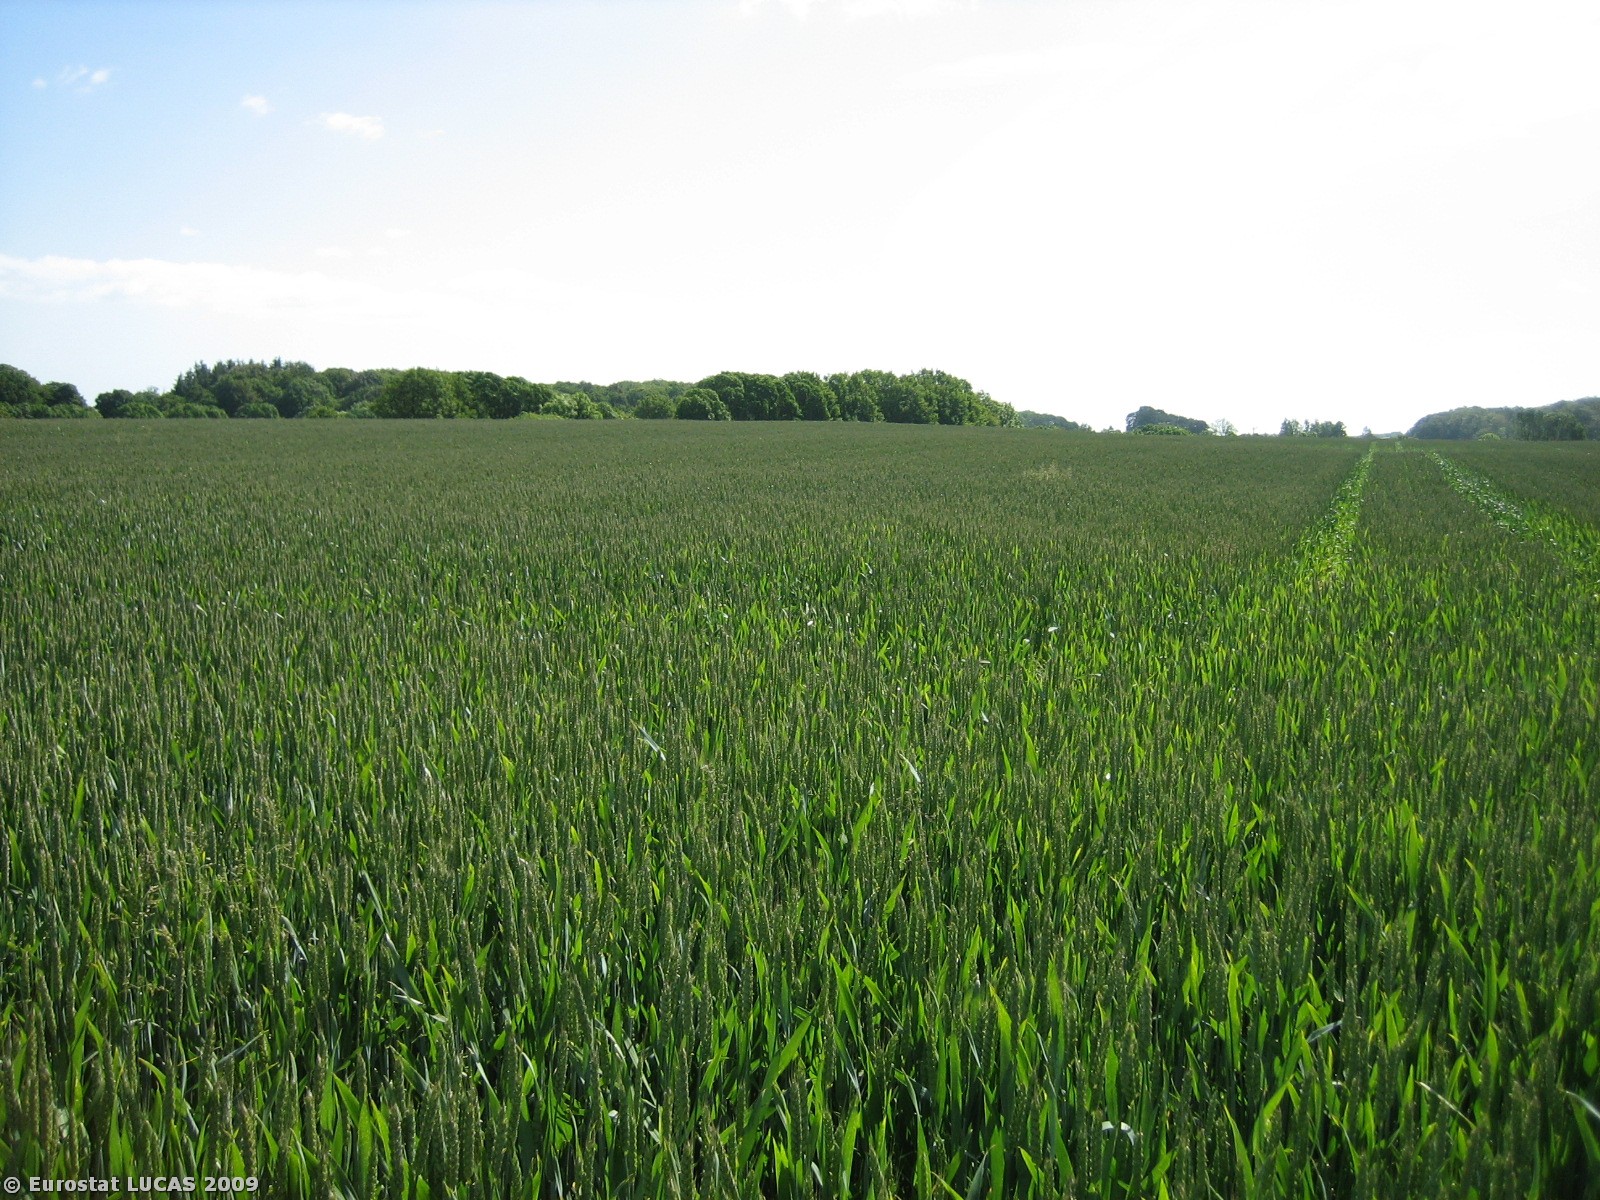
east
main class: Cropland
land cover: Common wheat
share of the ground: > 75 %
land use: Agriculture (excluding fallow land and kitchen gardens)
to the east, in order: Common wheat; Shruby margins; Broadleaved woodland; Rape and turnip rape
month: June
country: DK
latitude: 55.7563
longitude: 9.8886
